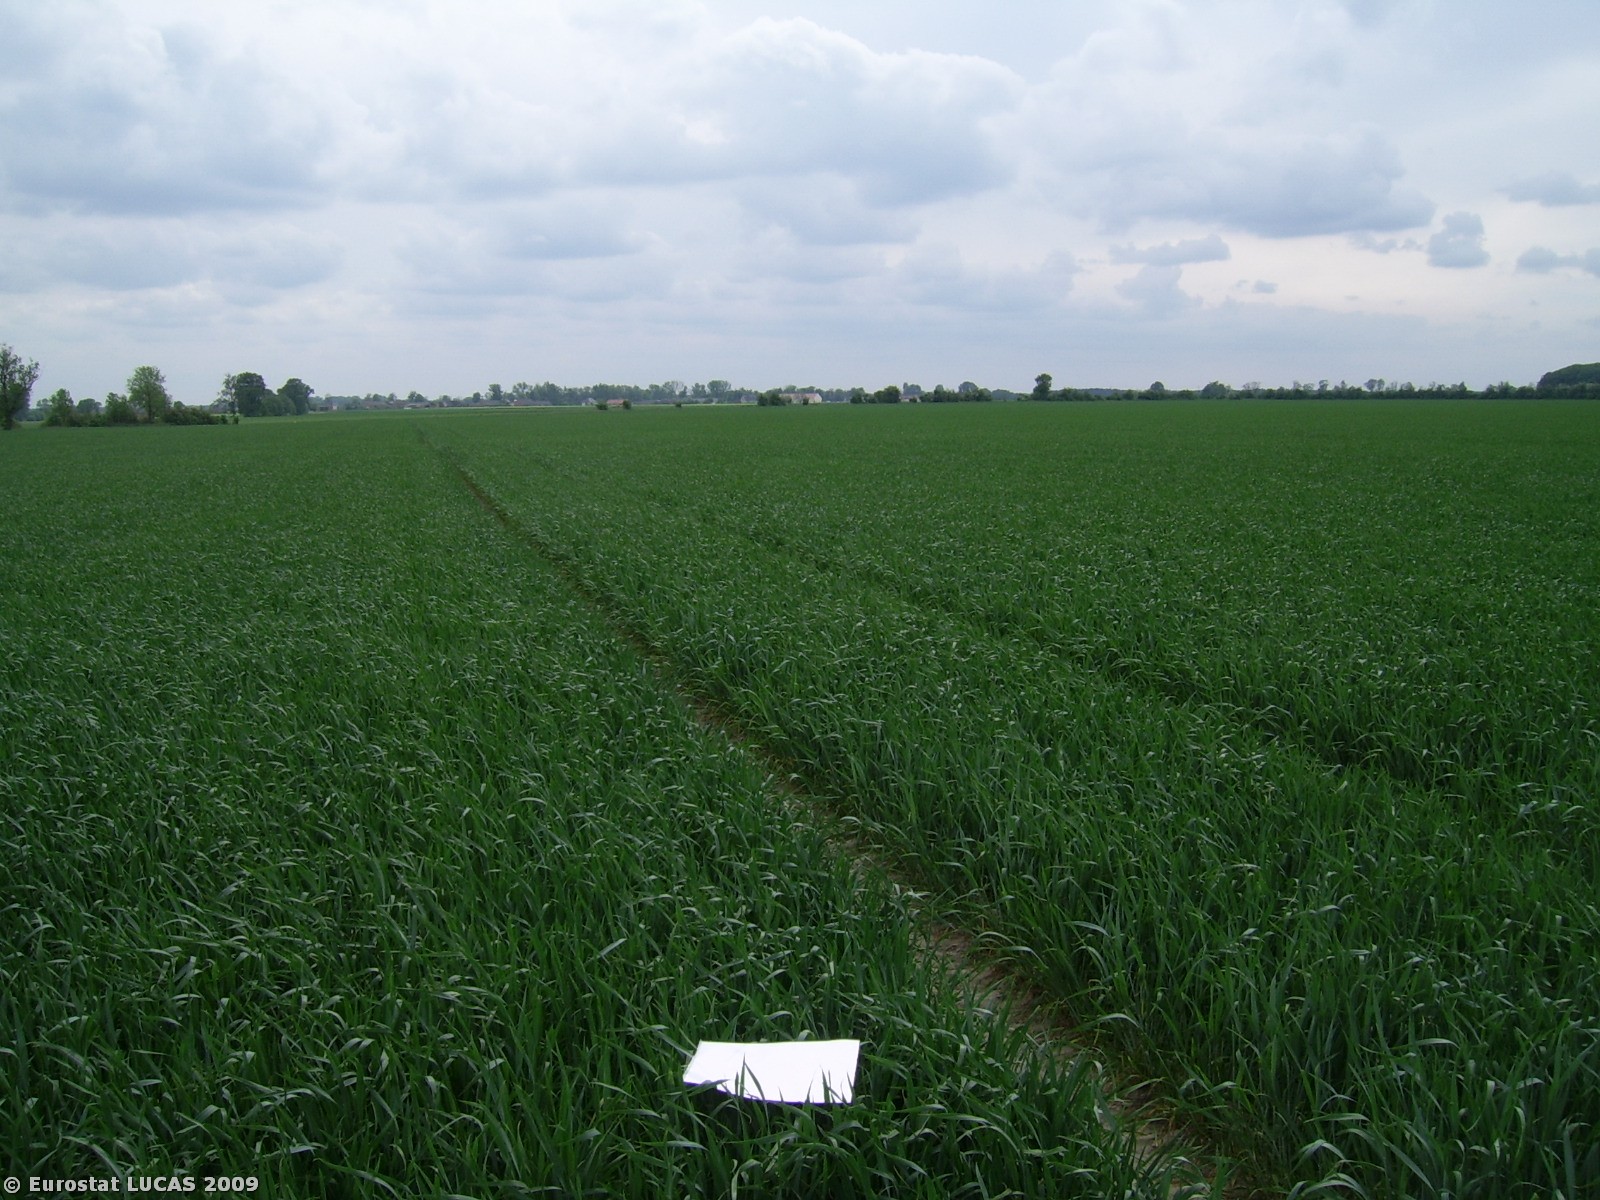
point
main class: Cropland
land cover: Common wheat
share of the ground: > 75 %
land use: Agriculture (excluding fallow land and kitchen gardens)
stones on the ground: < 10 %
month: May
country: PL
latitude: 51.8175
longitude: 16.8711
